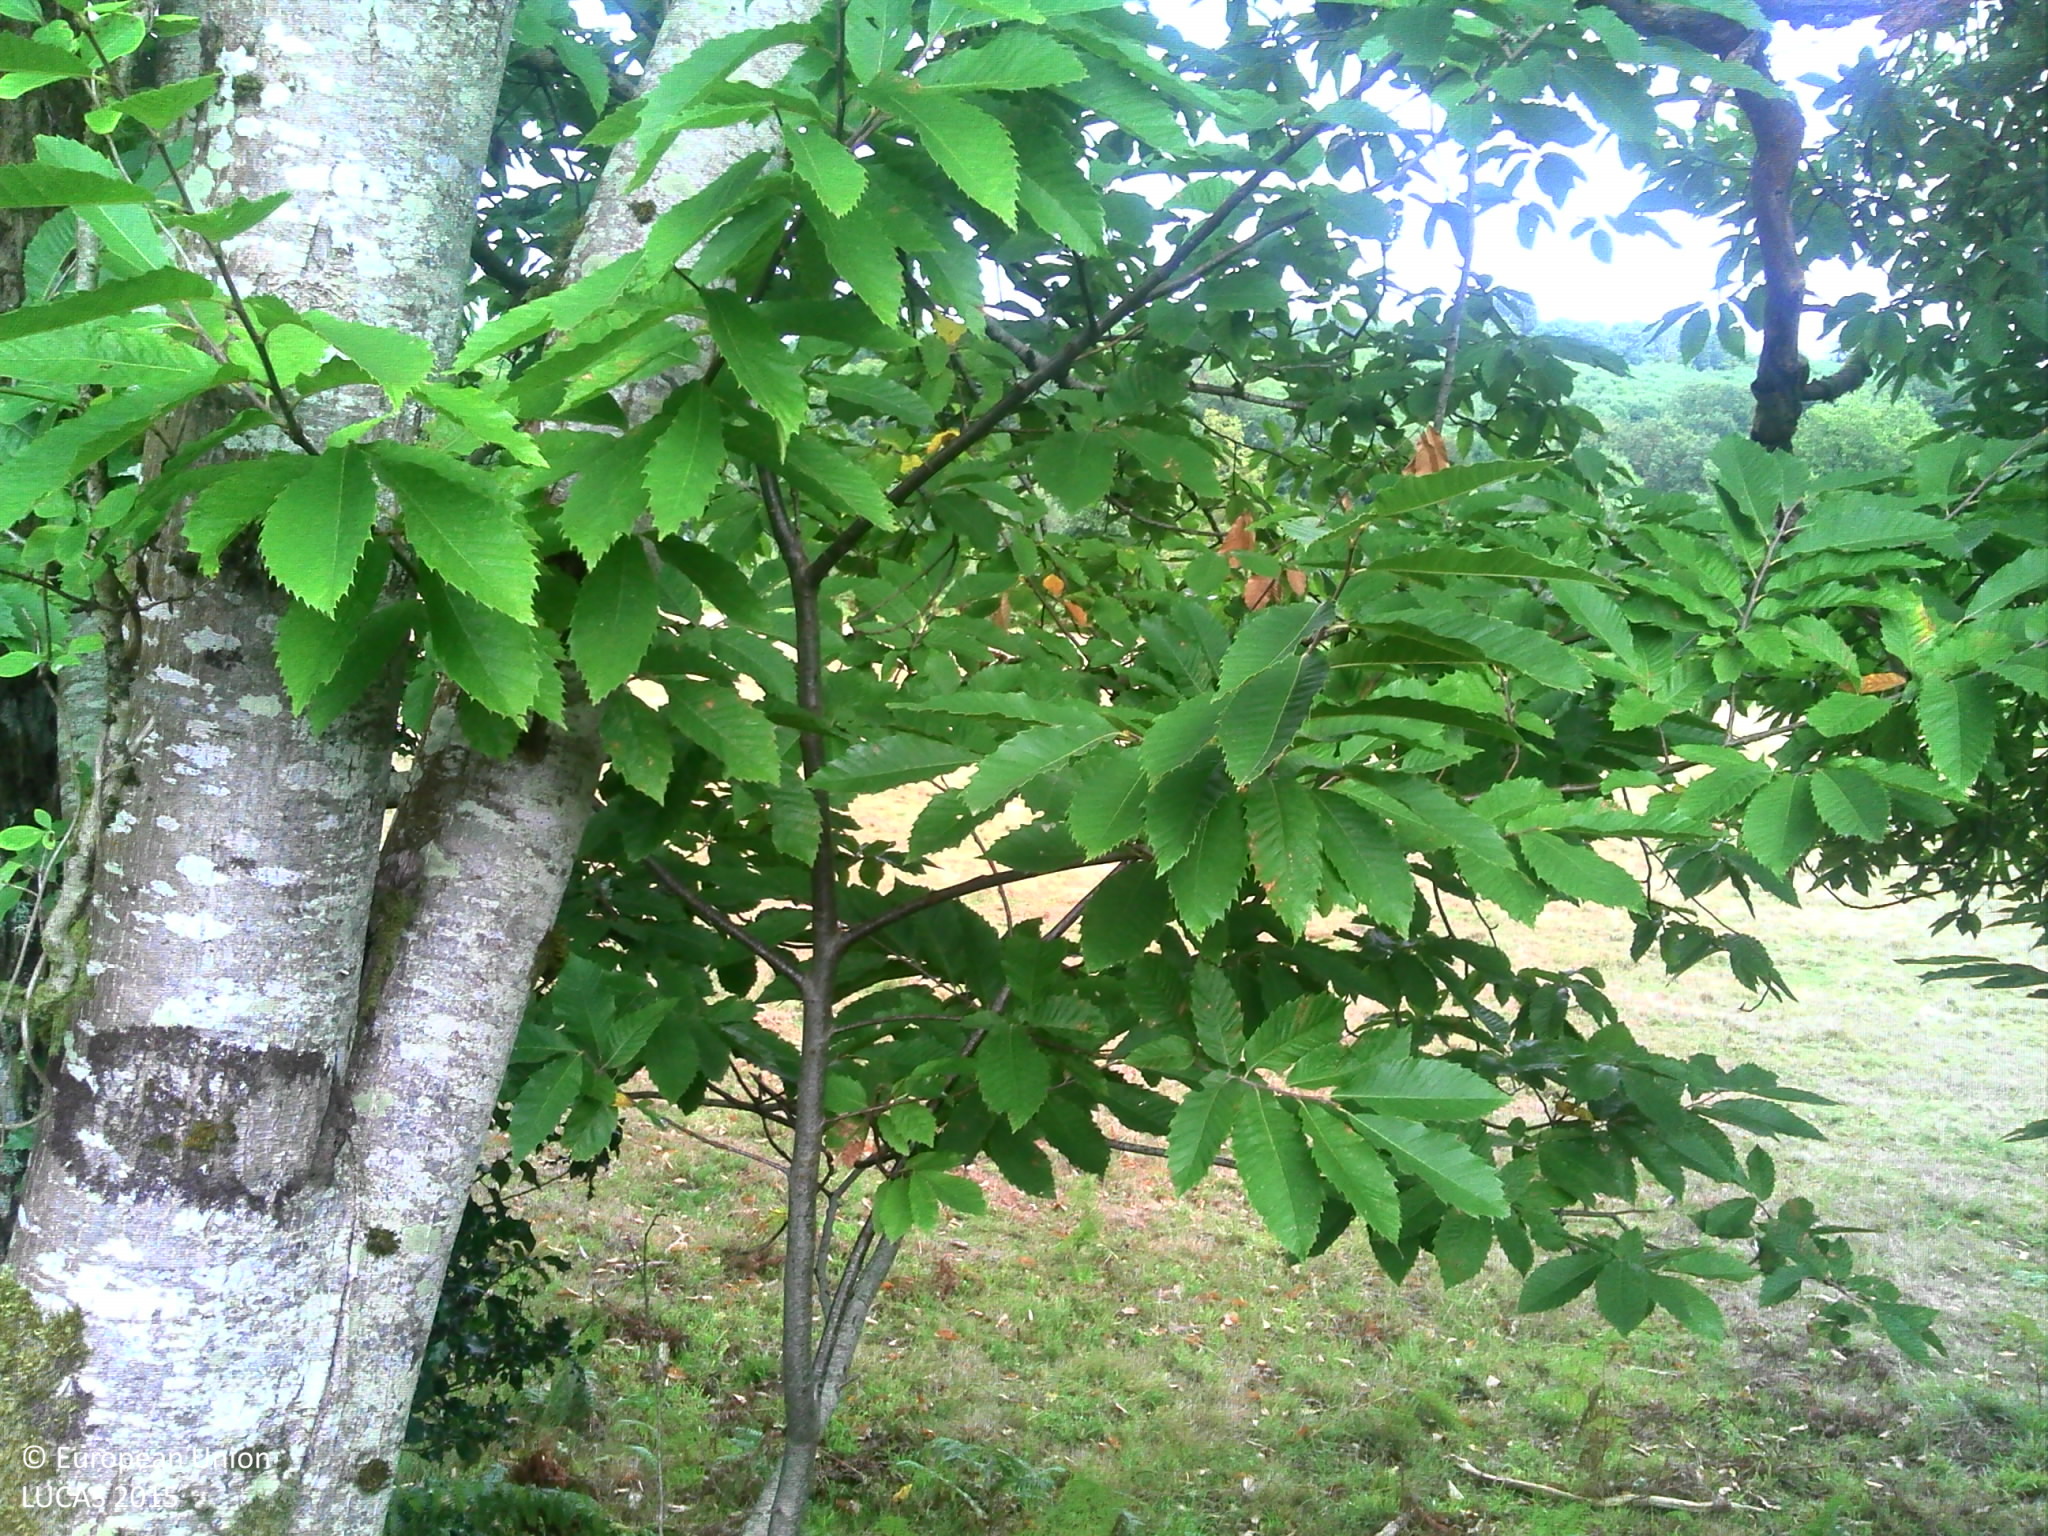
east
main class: Grassland
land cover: Grassland without tree/shrub cover
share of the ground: > 75 %
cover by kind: herbaceous plants 100 %
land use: Agriculture (excluding fallow land and kitchen gardens)
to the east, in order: Grassland without tree/shrub cover; Spontaneously vegetated surfaces; Shruby margins; Dry stone walls; Grassland with sparse tree/shrub cover; Fences; Rivers and streams; Shrubland with sparse tree cover; Broadleaved woodland; Tracks; Broadleaved woodland
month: August
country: FR
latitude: 46.0220
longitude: 0.9586
